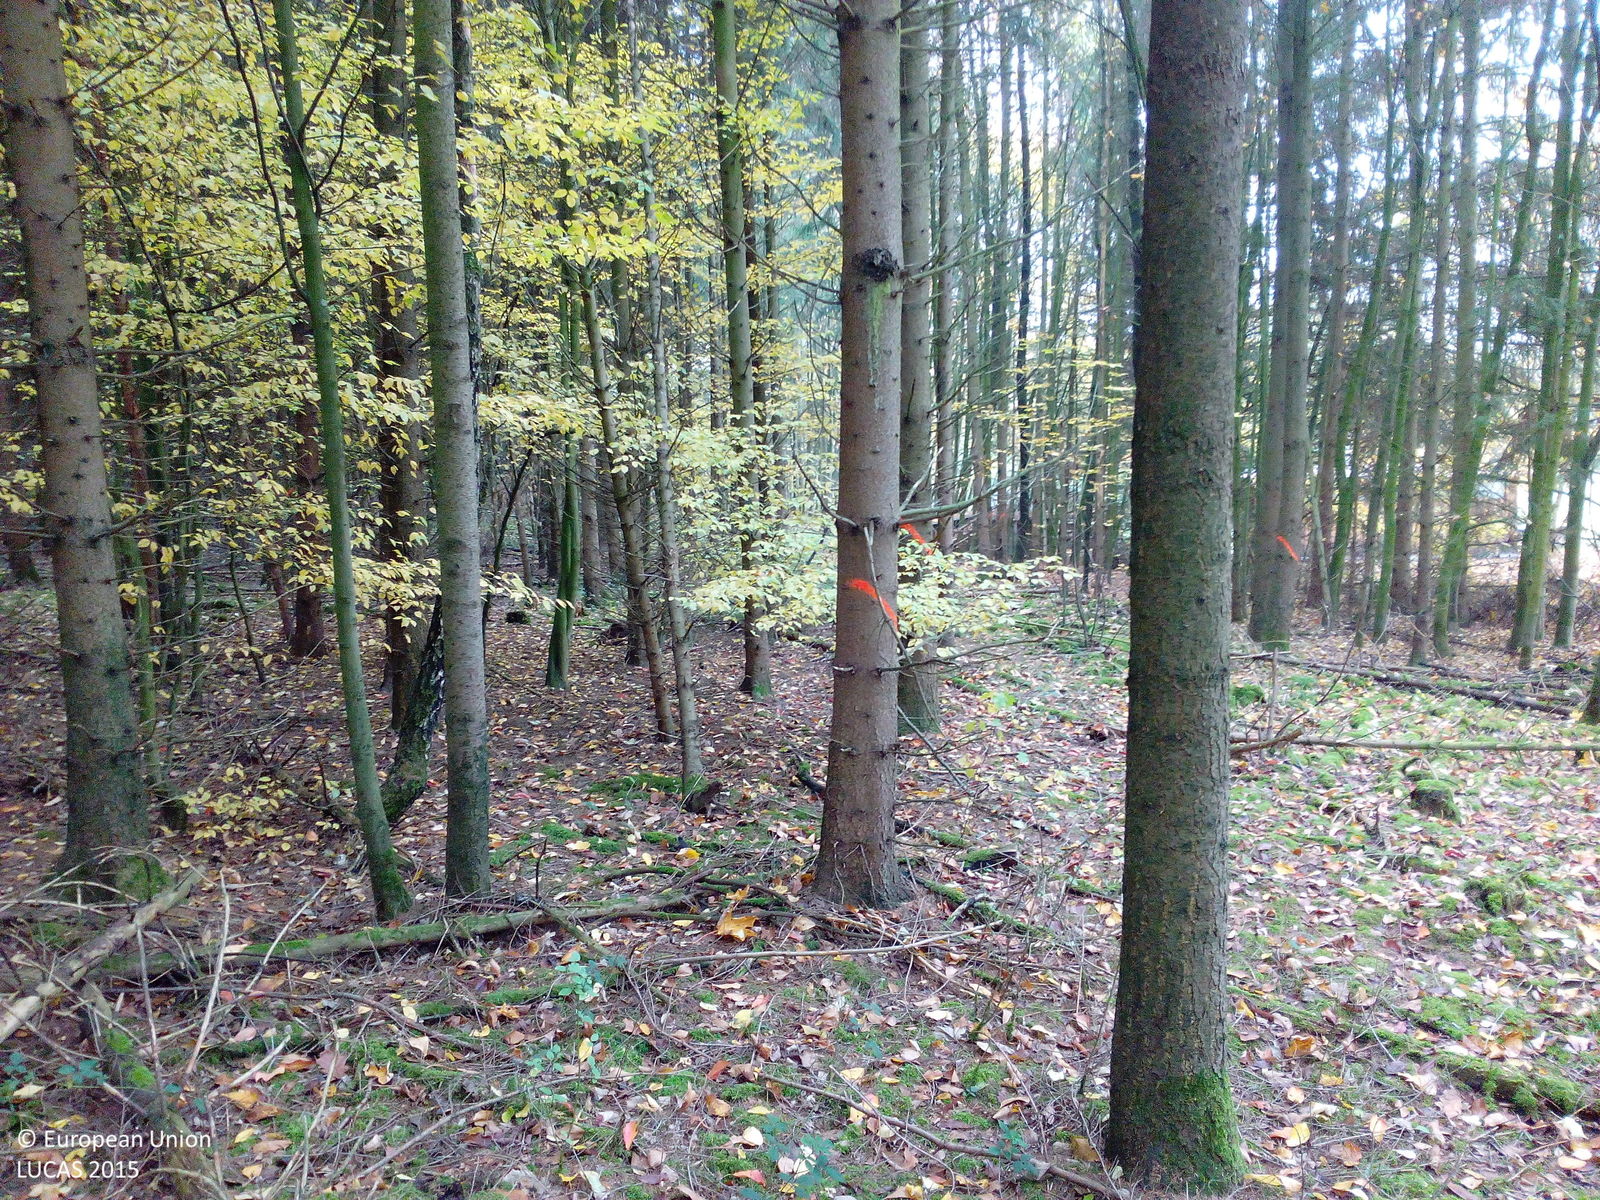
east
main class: Woodland
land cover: Spruce dominated mixed woodland
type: hemiboreal forest and nemoral coniferous forest and mixed broadleaved-coniferous forest
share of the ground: 50 - 75 %
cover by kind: coniferous forest trees 35 %, broadleaved forest trees 25 %, unconsolidated bare surface 20 %, lichens and mosses 15 %, shrubs 5 %
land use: Forestry
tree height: > 5 m
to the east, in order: Spruce dominated mixed woodland; Grassland without tree/shrub cover; Single bushes/trees; Grassland without tree/shrub cover; Other mixed woodland; Artificial constructions; Other mixed woodland; Broadleaved woodland; Ditches and canals; Grass margins; Tracks; Grass margins; Ditches and canals; Broadleaved woodland; Other mixed woodland
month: October
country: DE
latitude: 50.1662
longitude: 9.9580
